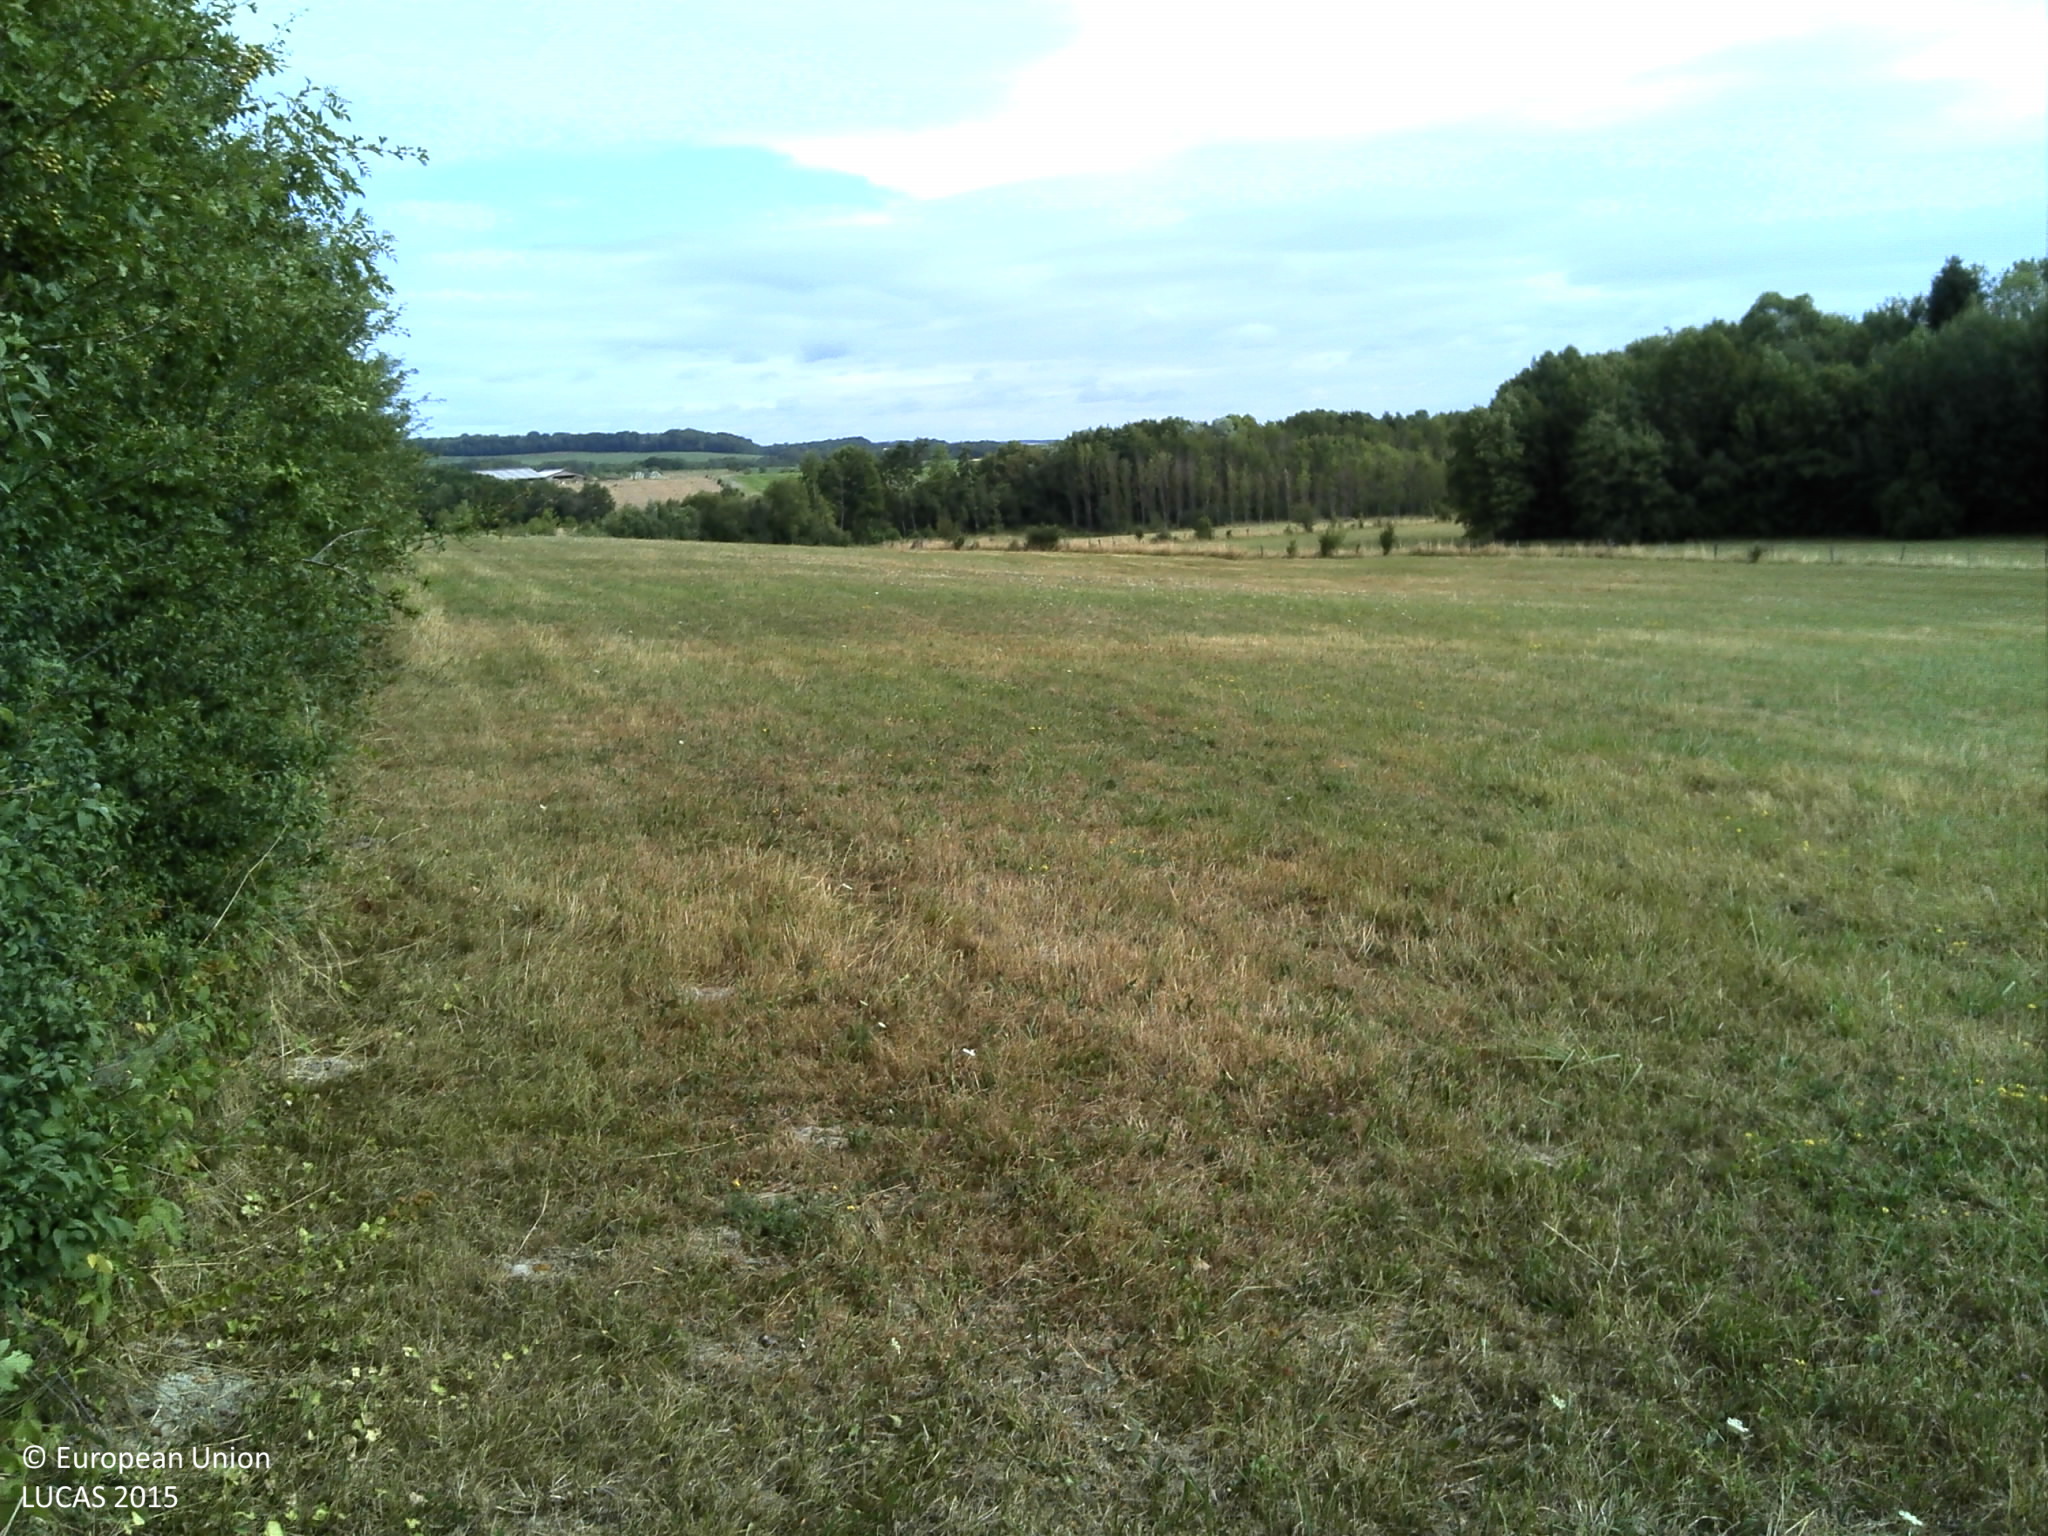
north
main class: Grassland
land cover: Grassland without tree/shrub cover
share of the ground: > 75 %
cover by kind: herbaceous plants 100 %
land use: Agriculture (excluding fallow land and kitchen gardens)
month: July
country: FR
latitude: 48.1192
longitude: 6.1183
